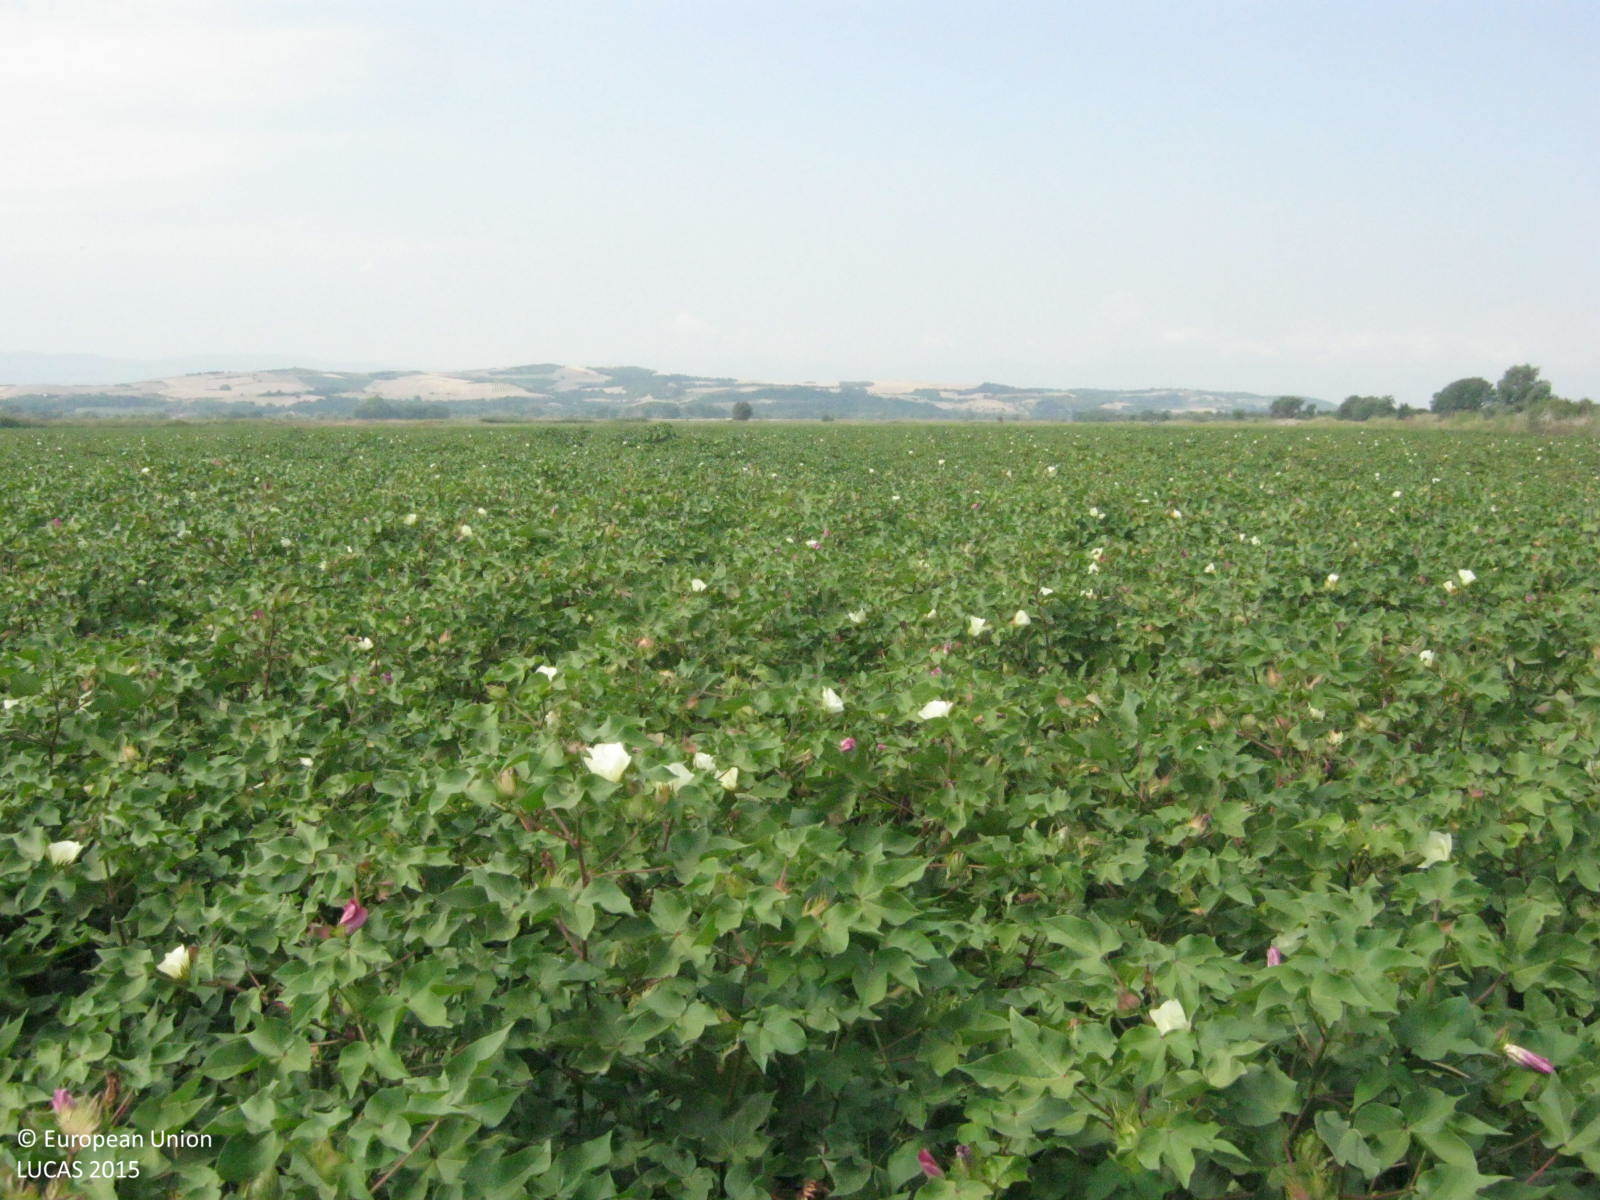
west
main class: Cropland
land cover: Cotton
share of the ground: > 75 %
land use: Agriculture (excluding fallow land and kitchen gardens)
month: August
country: GR
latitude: 40.5543
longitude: 22.5552
